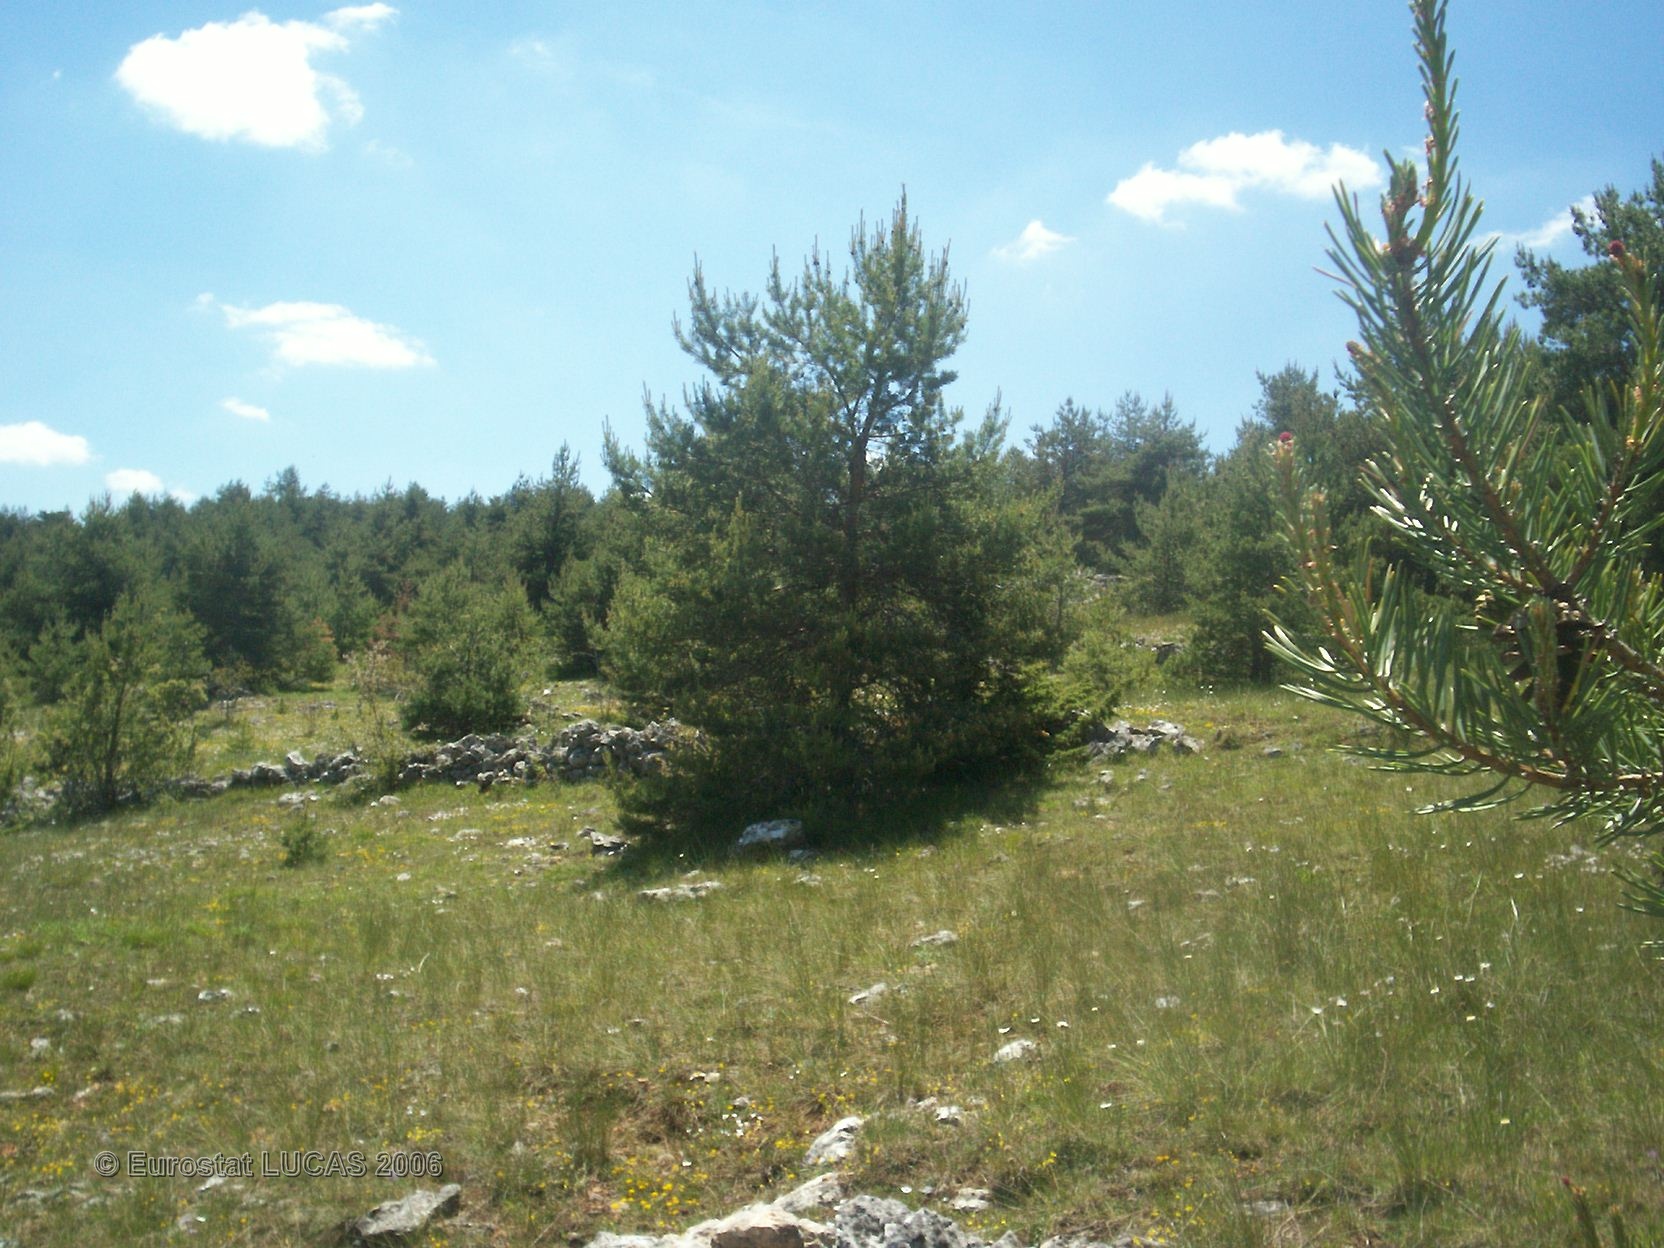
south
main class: Grassland
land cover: Grassland with sparse tree/shrub cover
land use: Agriculture (excluding fallow land and kitchen gardens)
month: June
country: FR
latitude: 44.2673
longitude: 3.4041
